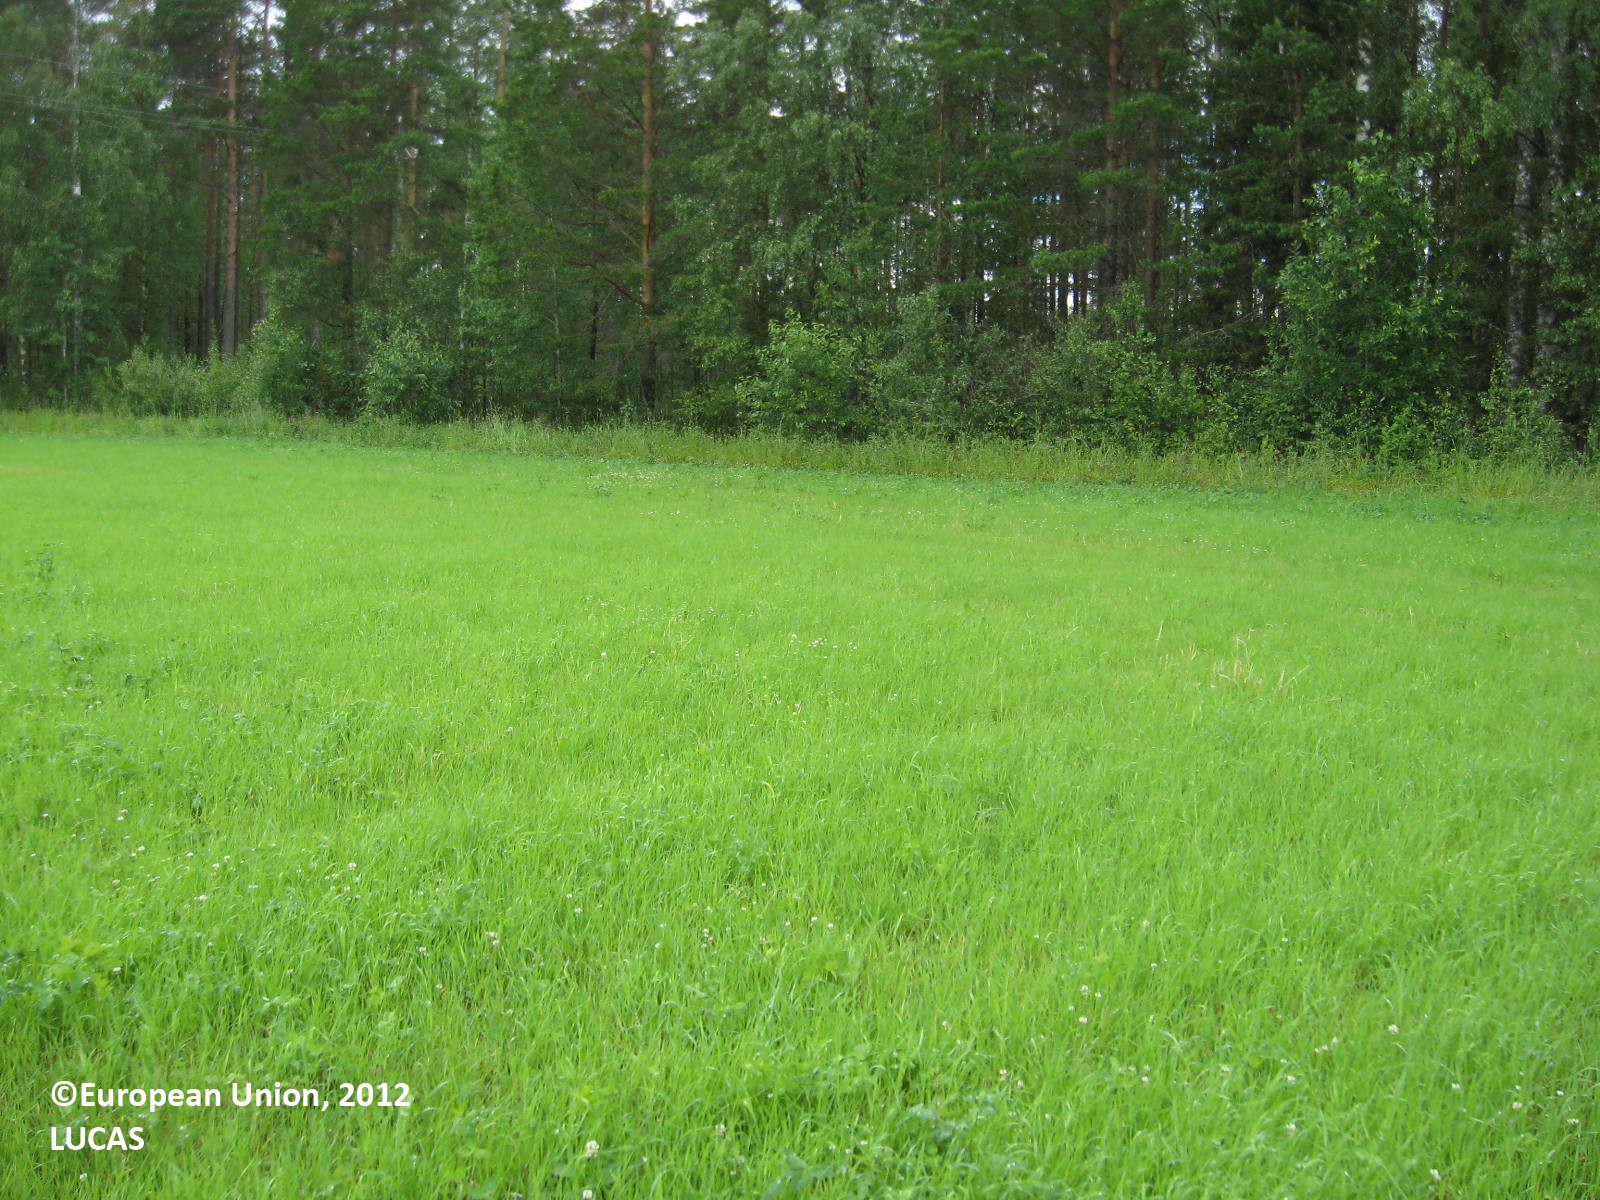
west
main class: Cropland
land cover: Temporary grasslands
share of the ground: > 75 %
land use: Agriculture (excluding fallow land and kitchen gardens)
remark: Harvested field
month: July
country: FI
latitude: 62.3183
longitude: 22.8159
